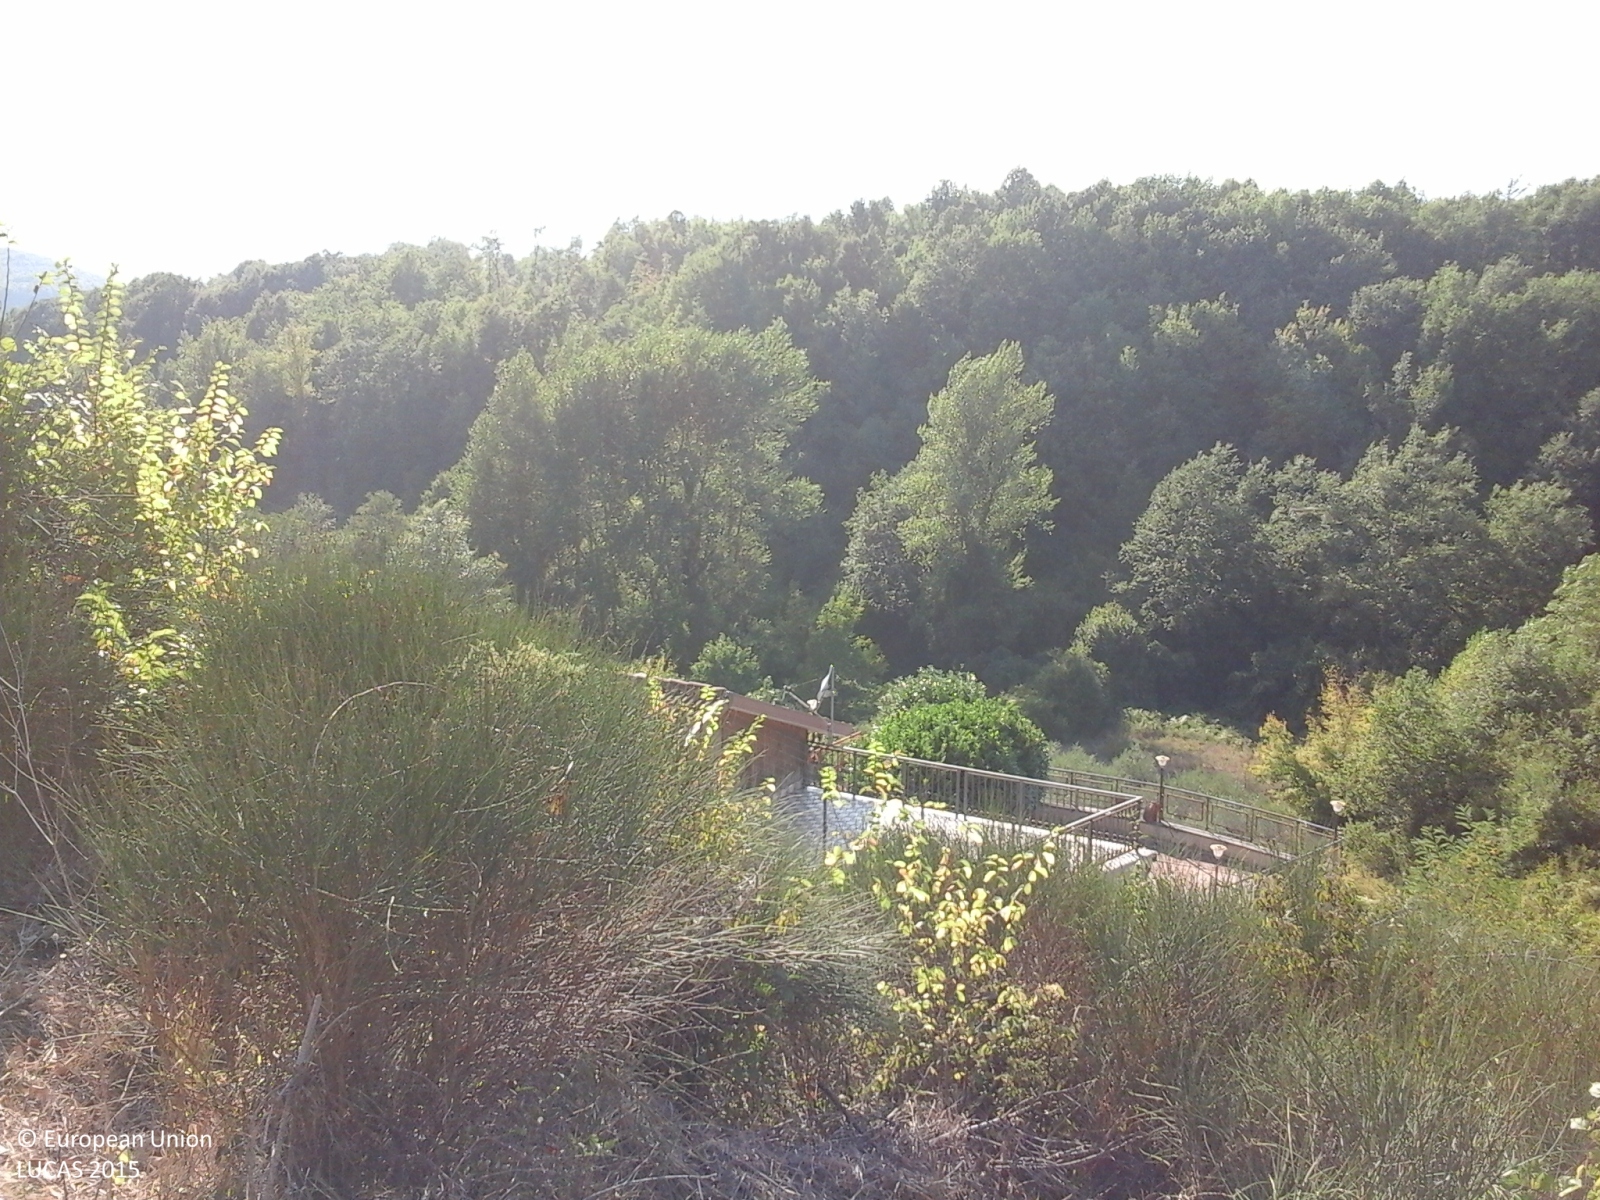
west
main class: Woodland
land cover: Broadleaved woodland
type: thermophilous deciduous forest
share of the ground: > 75 %
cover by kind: broadleaved forest trees 85 %, shrubs 10 %, herbaceous plants 5 %
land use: Semi-natural and natural areas not in use
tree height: > 5 m
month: September
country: IT
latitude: 41.5732
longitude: 14.1705
